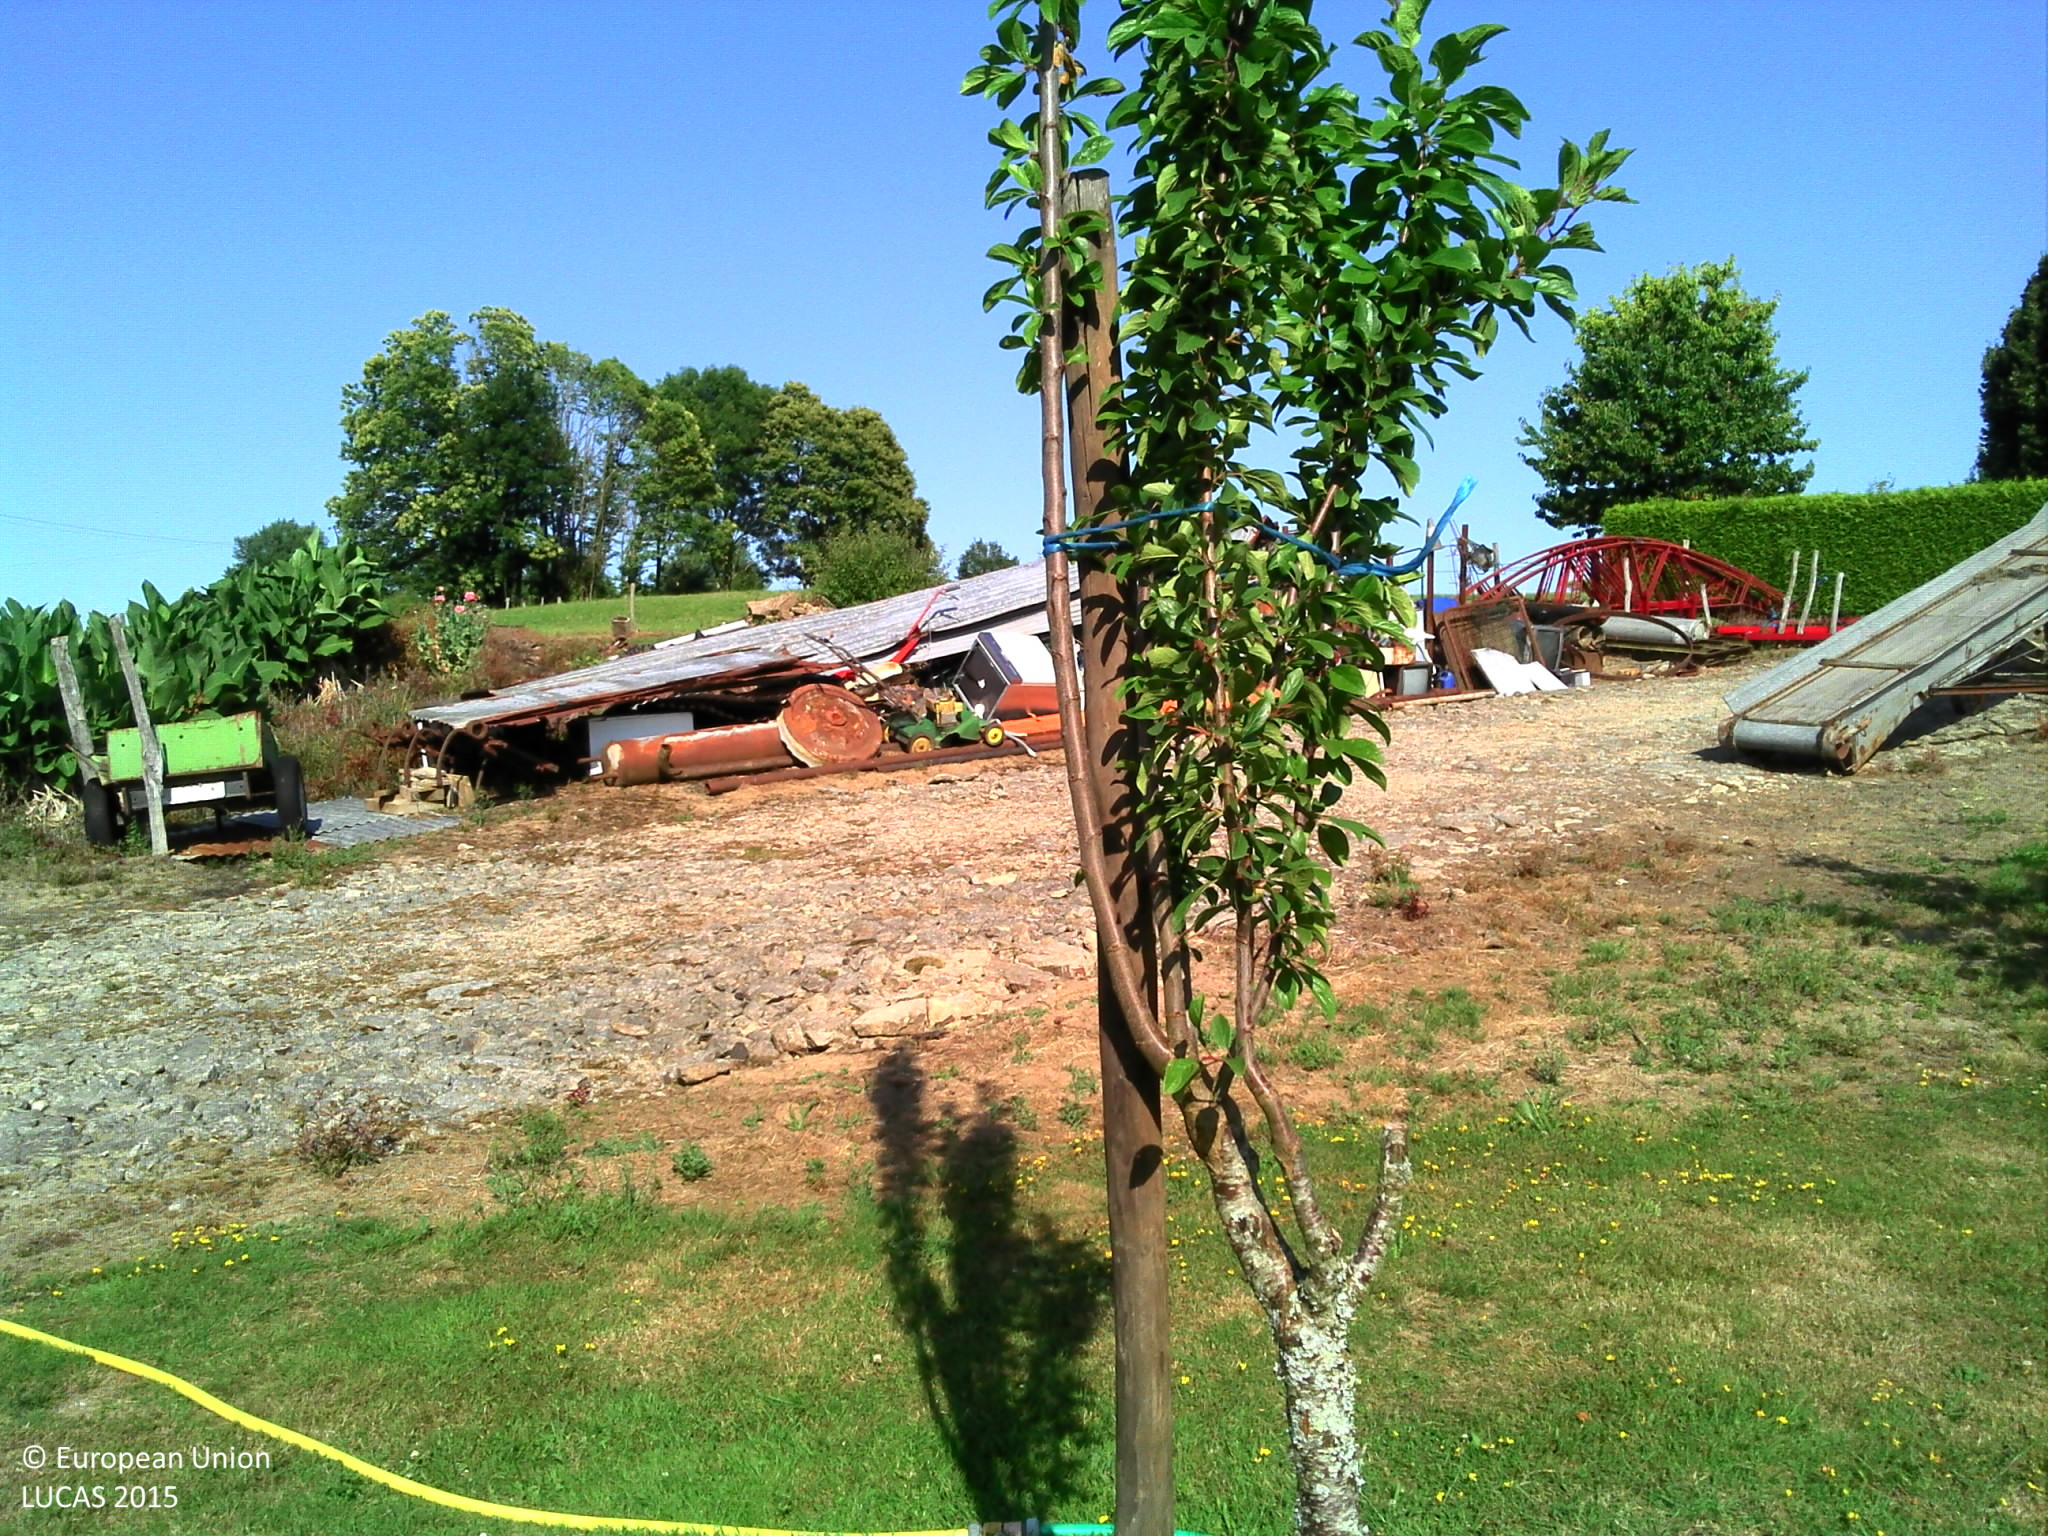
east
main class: Grassland
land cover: Grassland with sparse tree/shrub cover
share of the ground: > 75 %
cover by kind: herbaceous plants 95 %, broadleaved forest trees 5 %
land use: Residential
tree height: > 5 m
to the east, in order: Grassland with sparse tree/shrub cover; Other bare soil; Fences; Grassland without tree/shrub cover; Single bushes/trees; Fences; Grassland with sparse tree/shrub cover; Fences; Grassland without tree/shrub cover; Lines of trees; Tracks; Fences; Grassland without tree/shrub cover
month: June
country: FR
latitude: 45.7363
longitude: 0.5922
